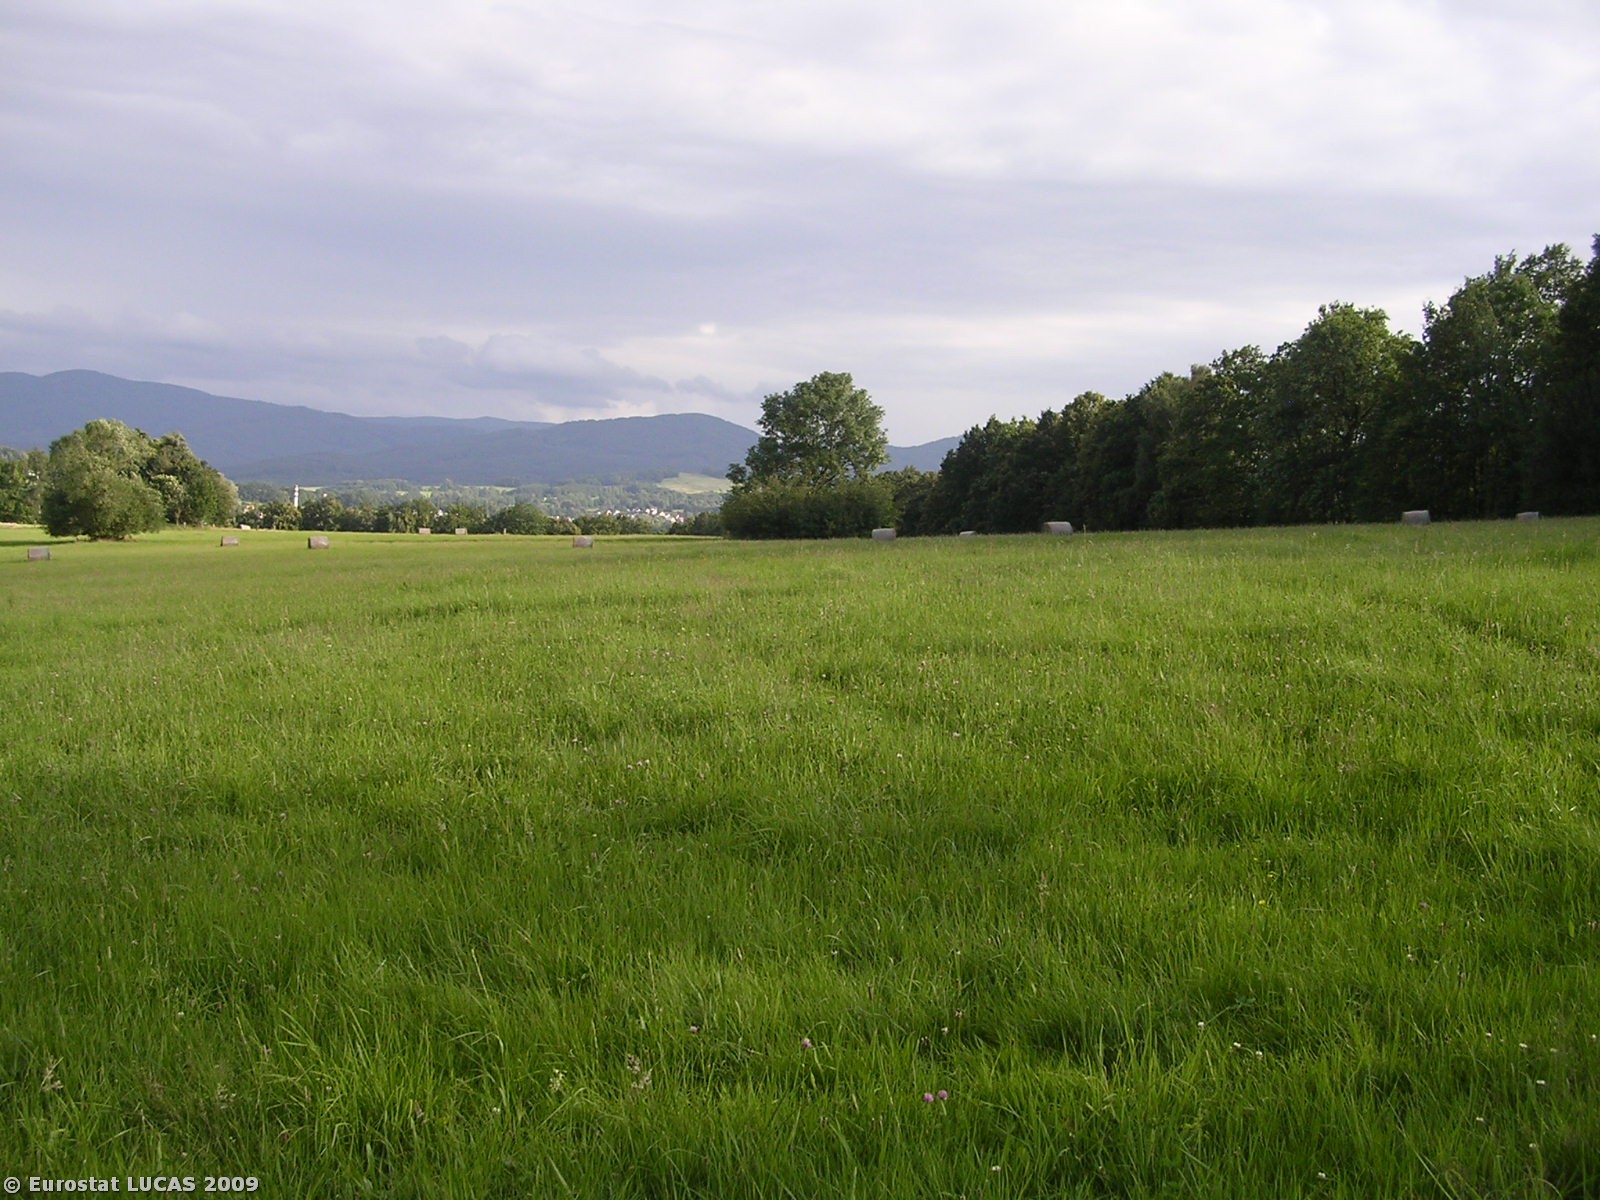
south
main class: Grassland
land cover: Grassland without tree/shrub cover
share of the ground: > 75 %
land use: Agriculture (excluding fallow land and kitchen gardens)
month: July
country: CZ
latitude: 50.9357
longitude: 15.0832
